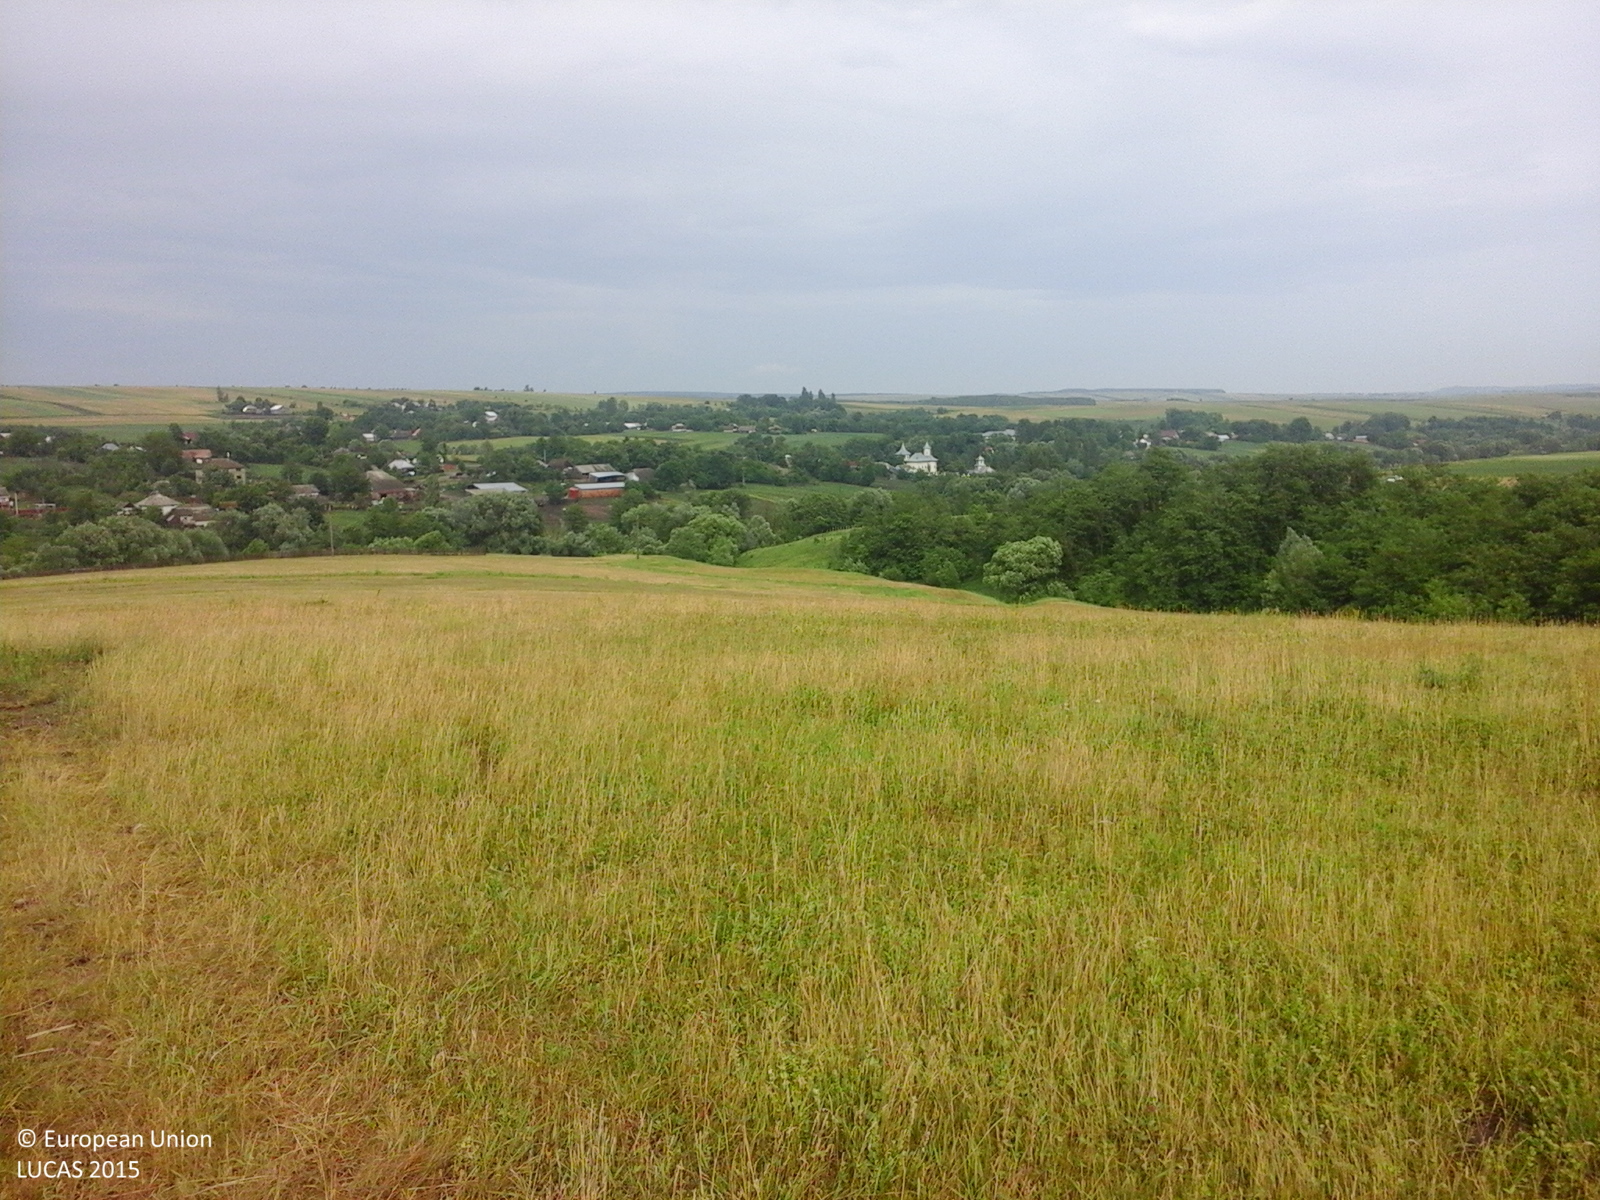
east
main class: Grassland
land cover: Grassland without tree/shrub cover
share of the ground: 25 - 50 %
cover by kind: herbaceous plants 100 %
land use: Agriculture (excluding fallow land and kitchen gardens)
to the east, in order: Tracks; Grassland without tree/shrub cover; Grass margins; Ditches and canals; Grass margins; Tracks; Grass margins; Lucerne; Grass margins; Ditches and canals; Tracks; Grass margins
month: June
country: RO
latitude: 47.3852
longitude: 26.4188
